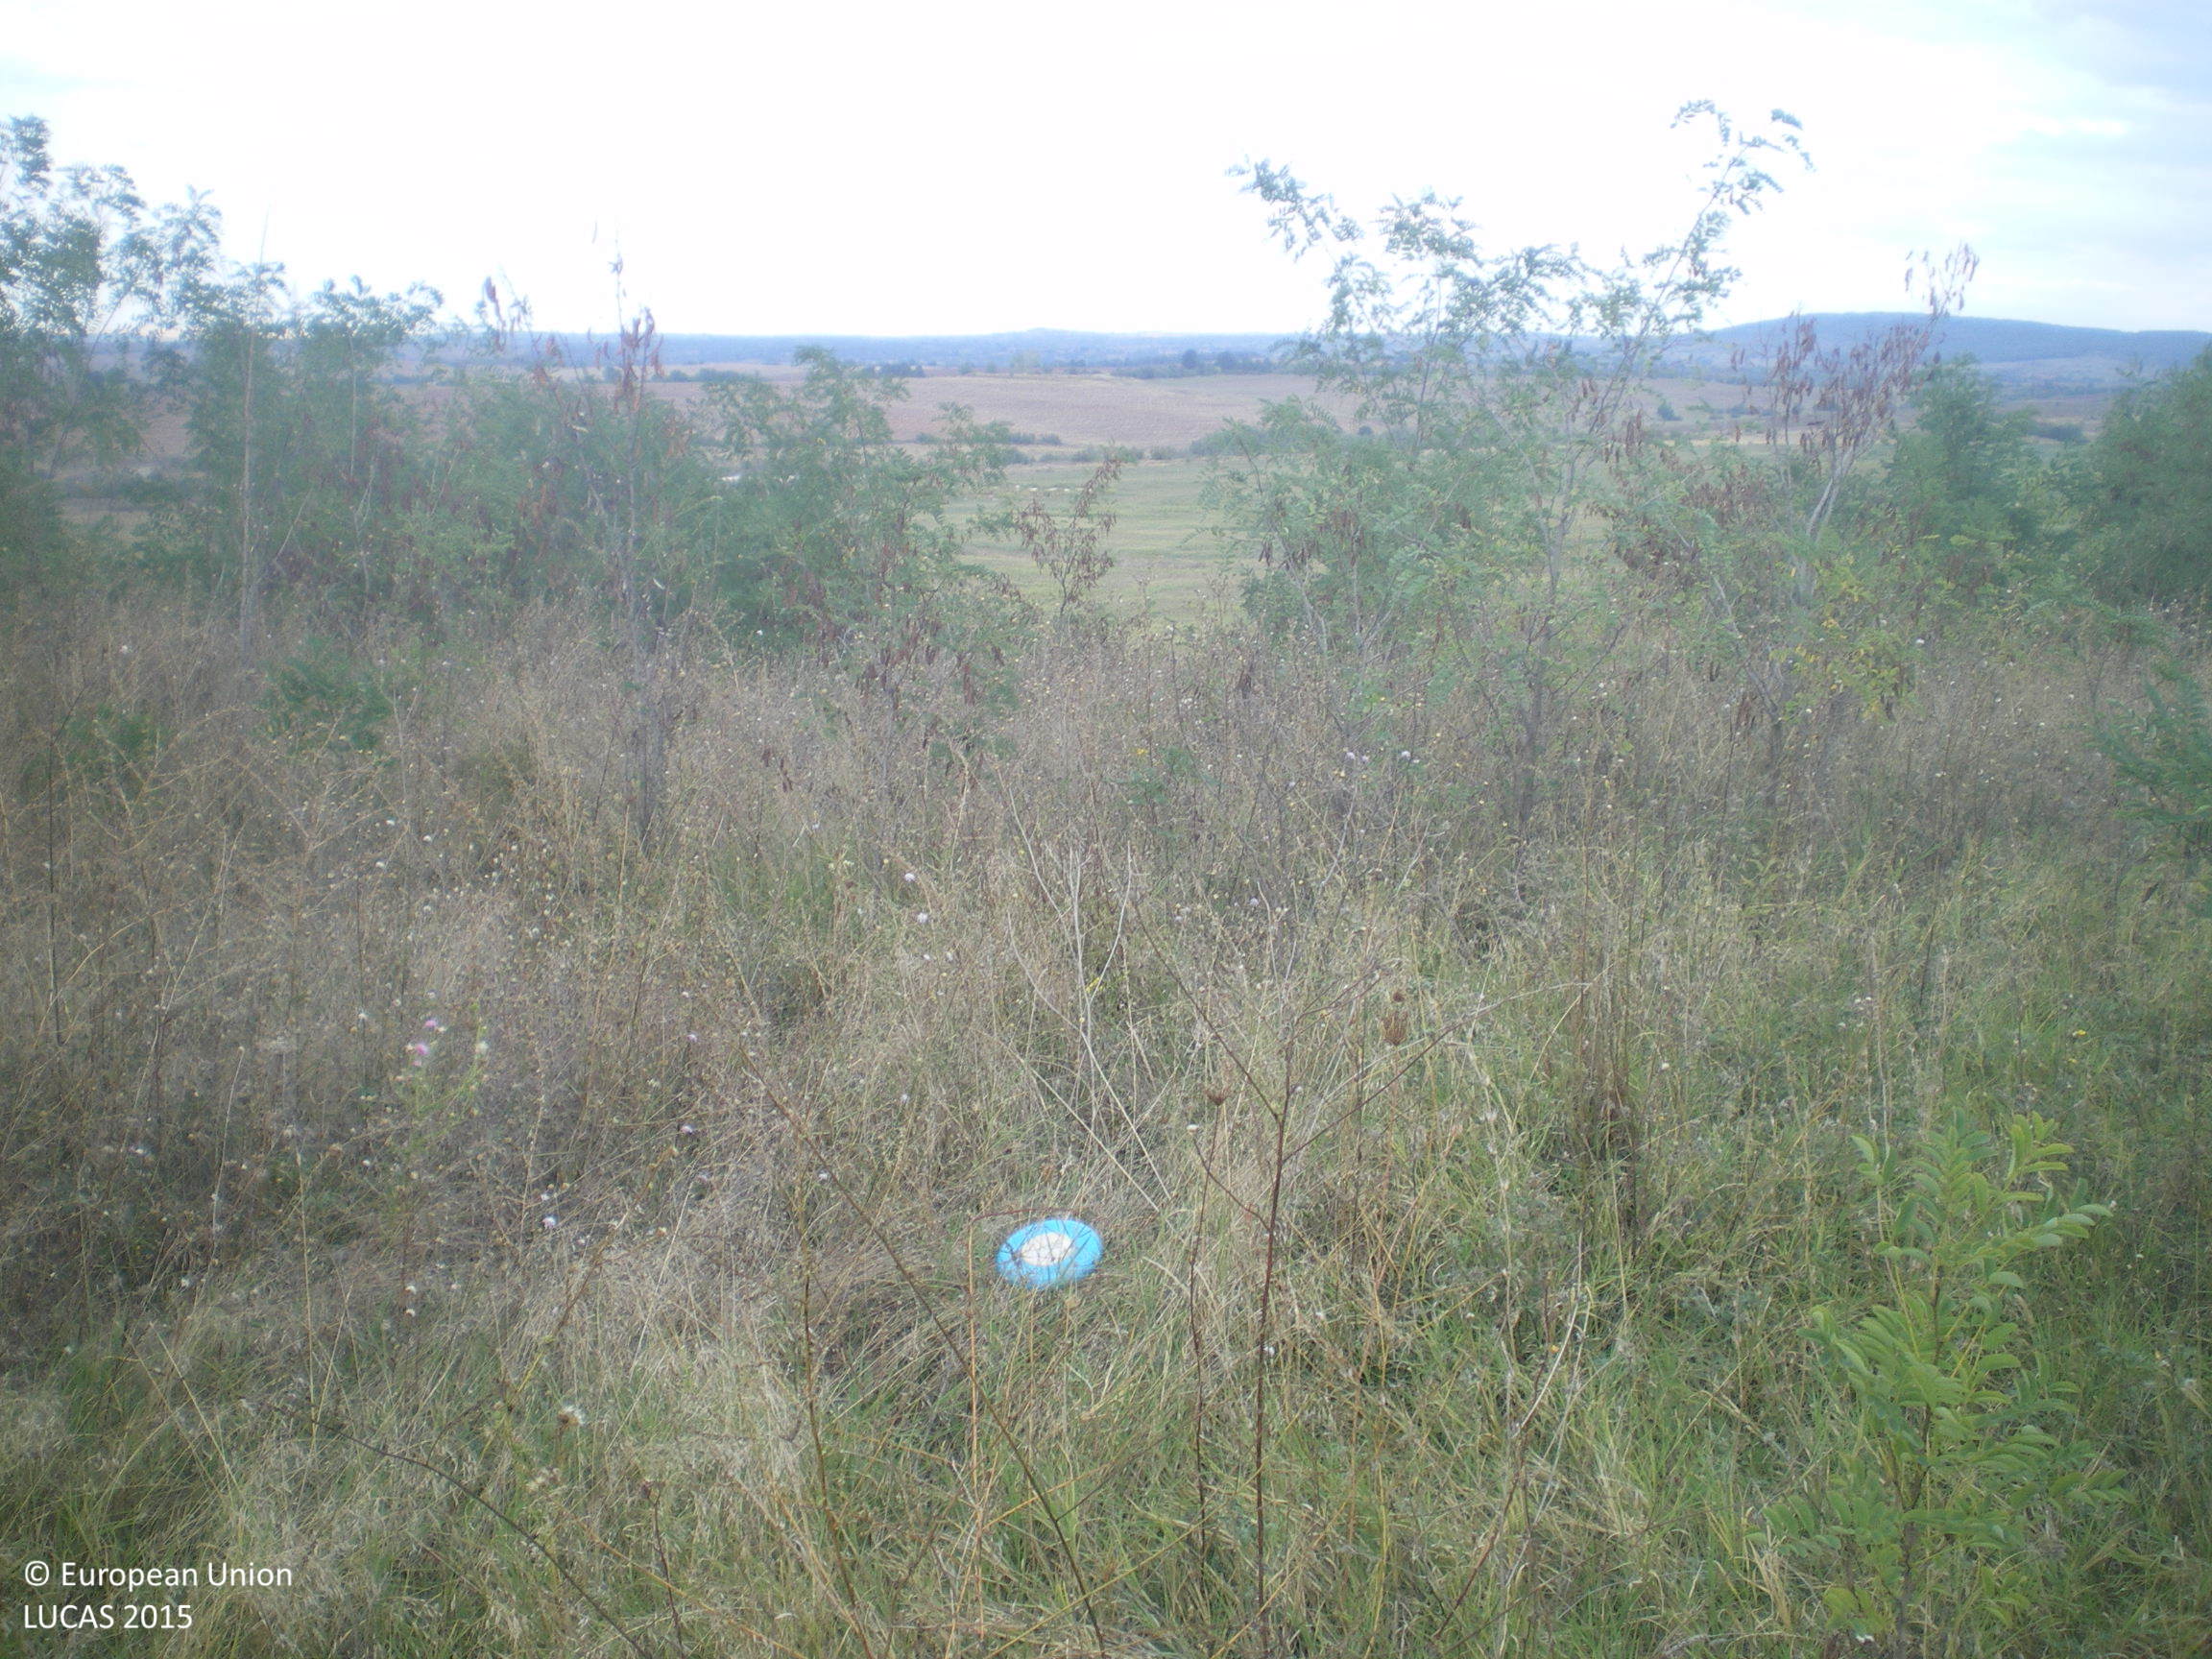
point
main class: Grassland
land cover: Grassland with sparse tree/shrub cover
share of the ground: > 75 %
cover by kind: herbaceous plants 85 %, shrubs 10 %, broadleaved forest trees 5 %
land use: Agriculture (excluding fallow land and kitchen gardens)
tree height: < 5 m
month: September
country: BG
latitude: 42.0956
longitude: 26.0736
